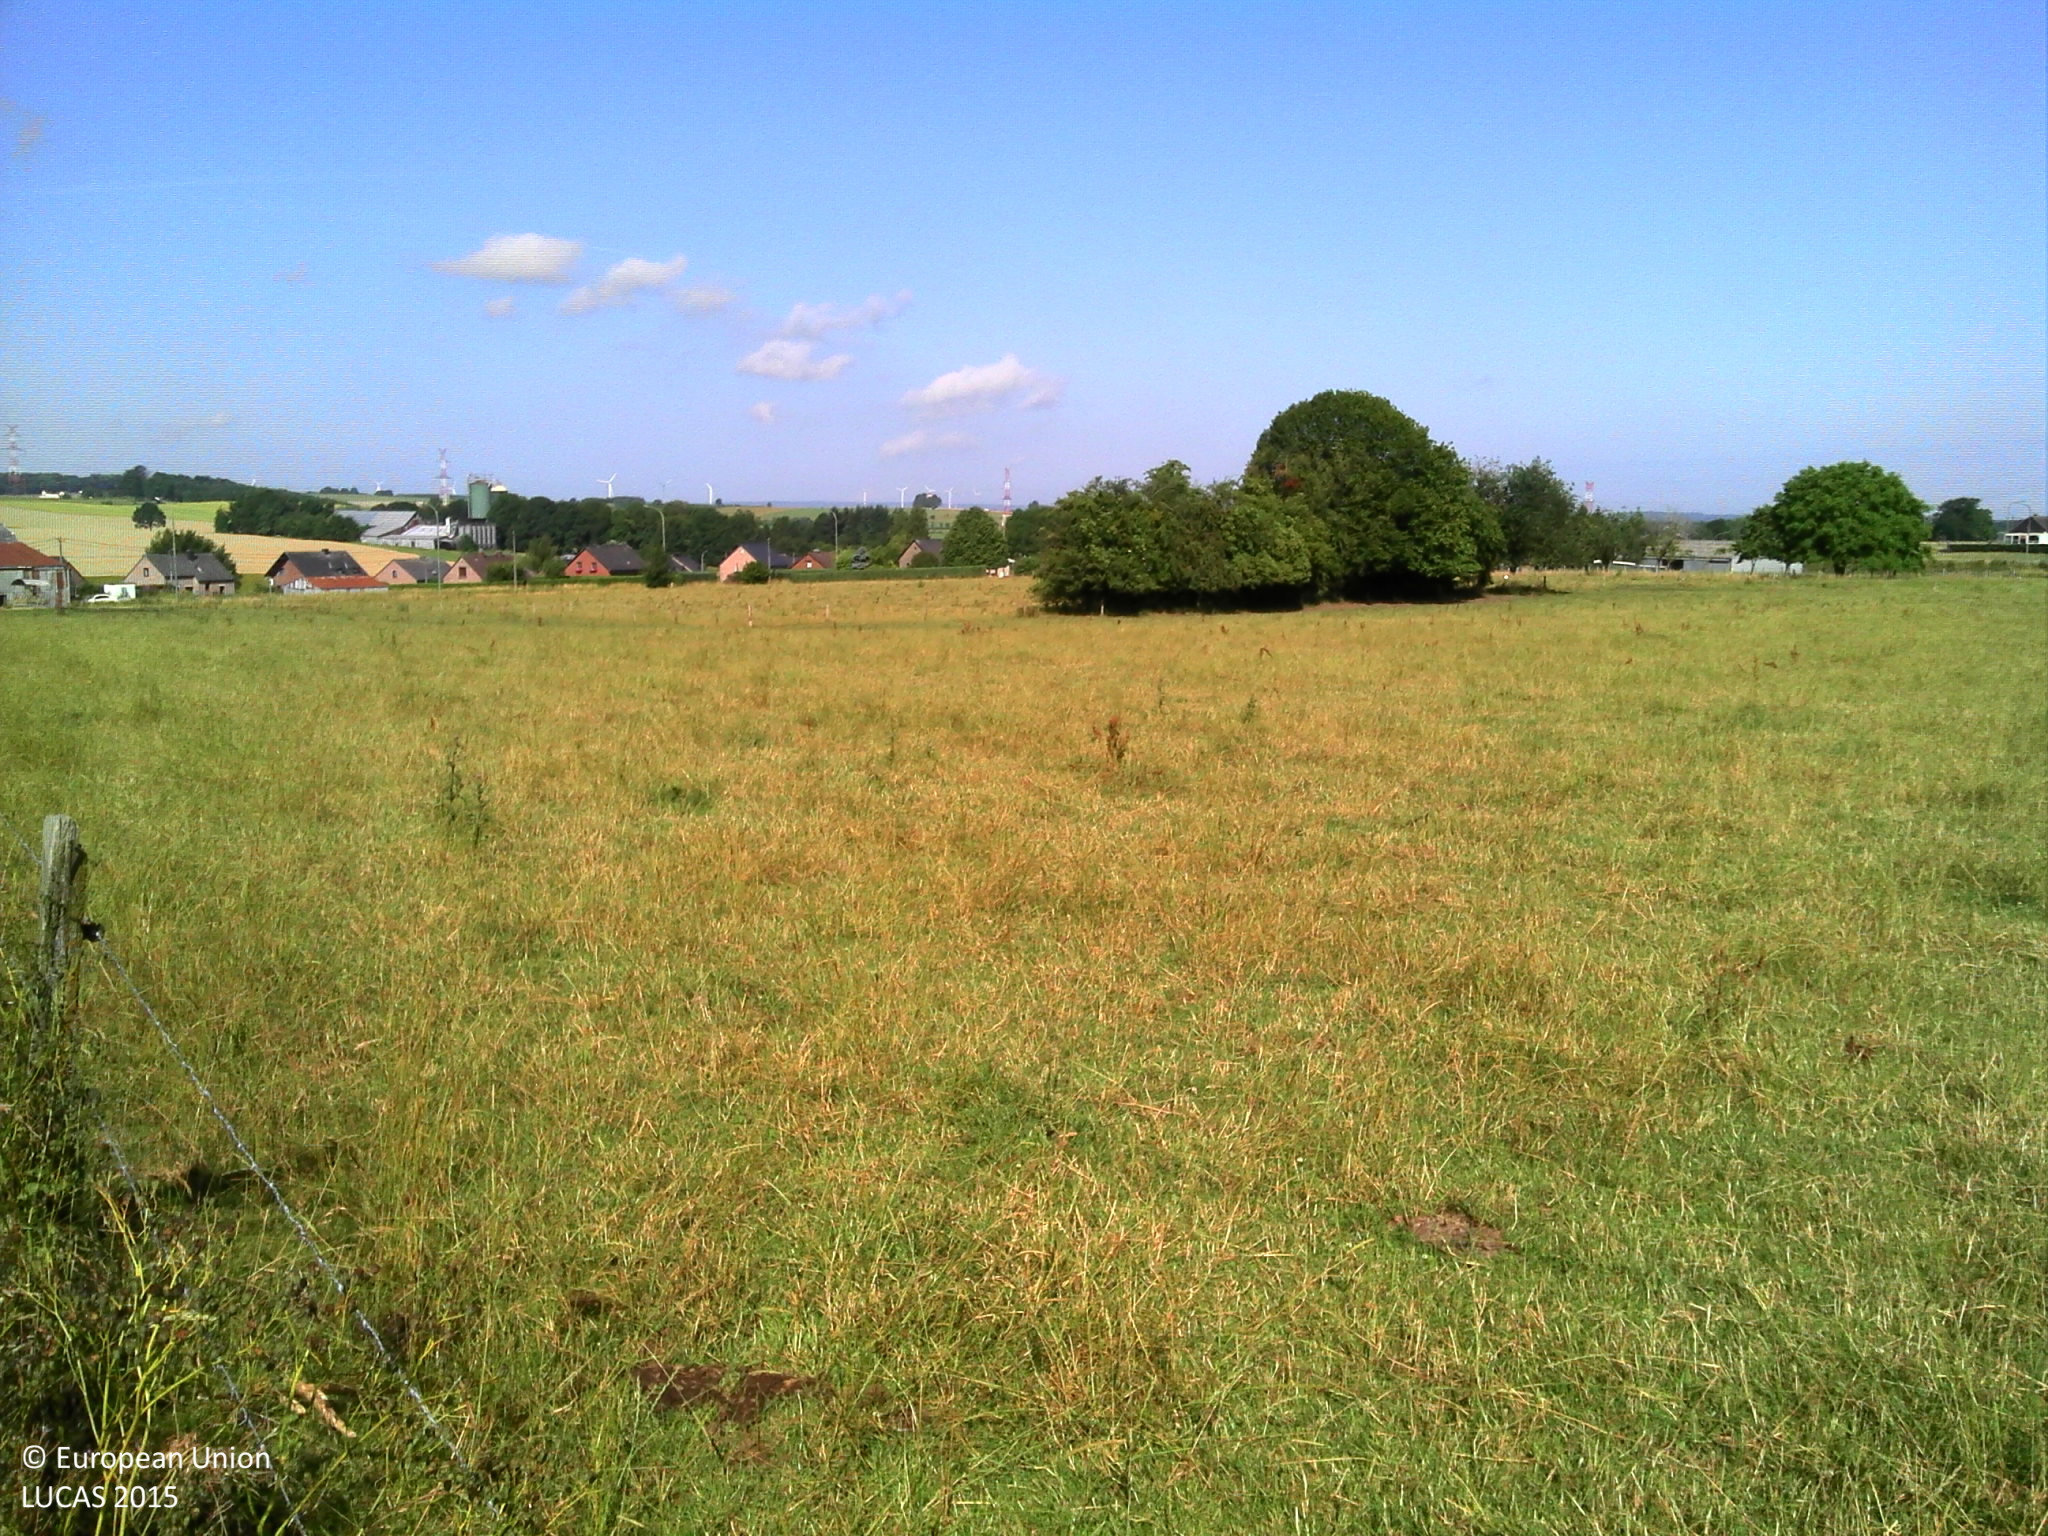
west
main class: Grassland
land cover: Grassland without tree/shrub cover
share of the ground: > 75 %
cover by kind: herbaceous plants 100 %
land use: Agriculture (excluding fallow land and kitchen gardens)
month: July
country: BE
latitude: 50.0137
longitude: 5.7145
